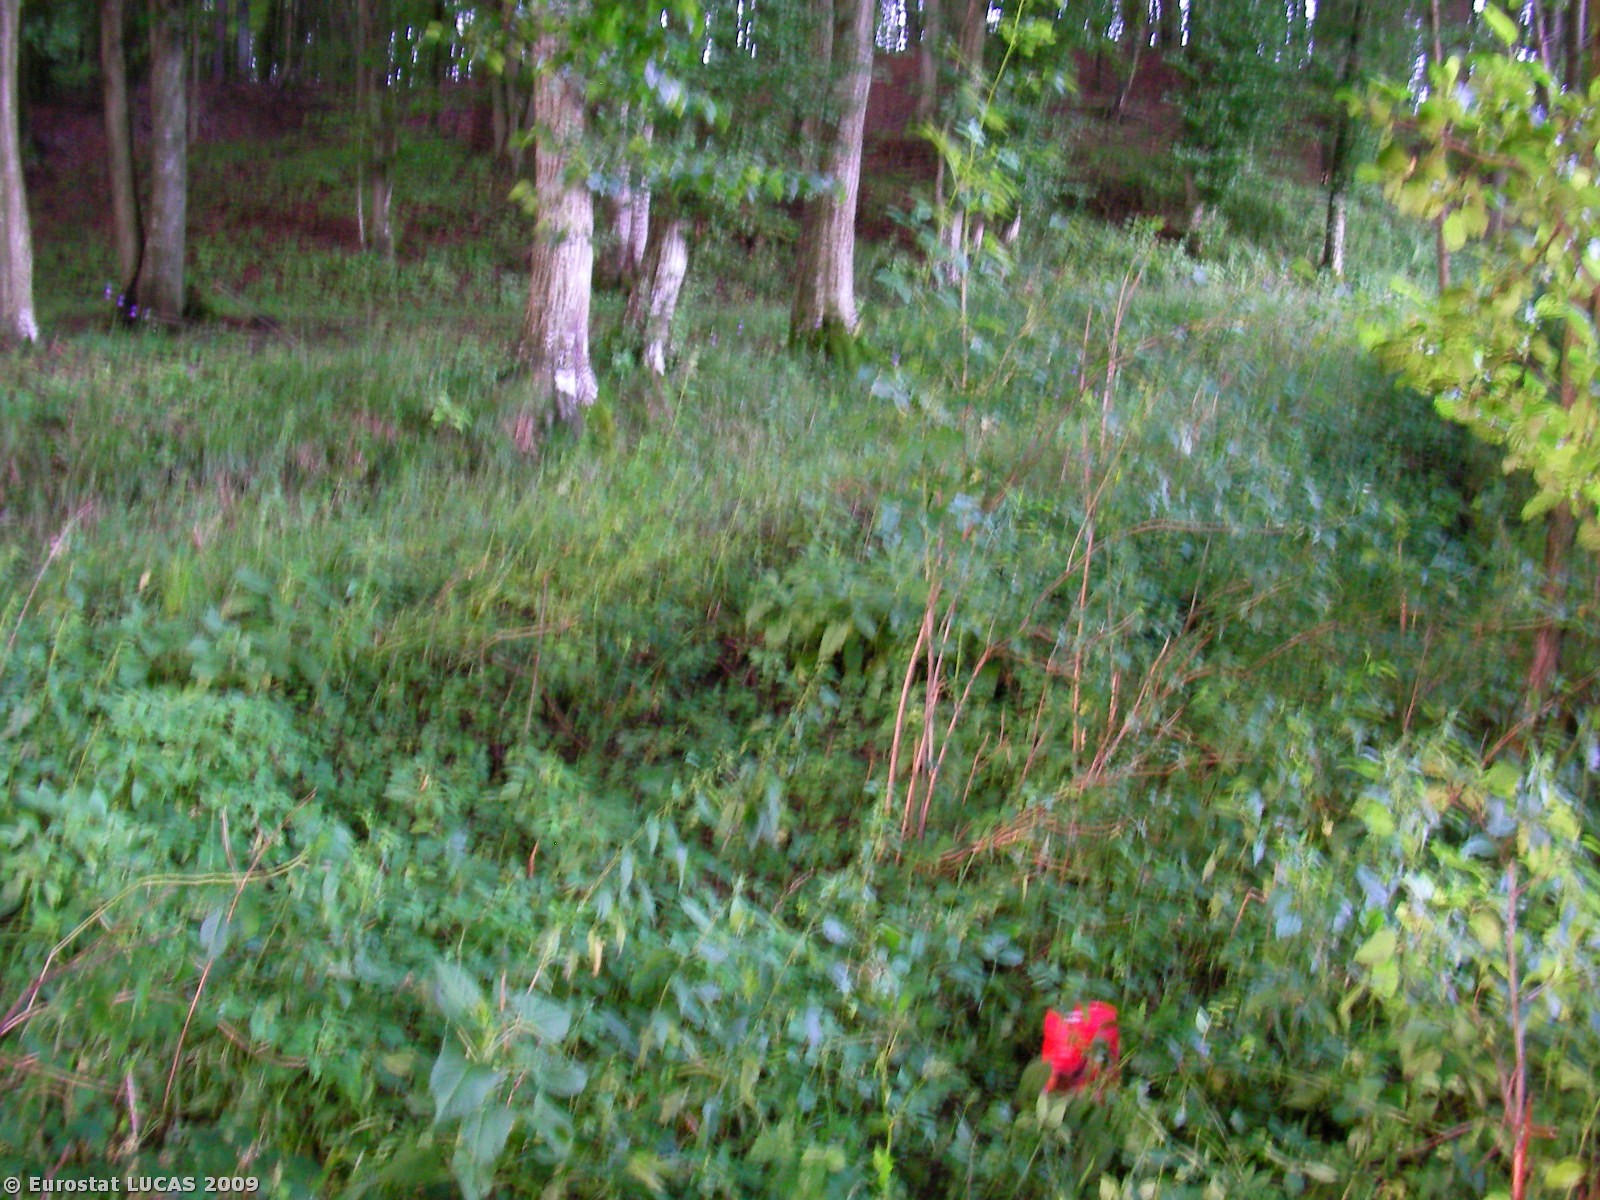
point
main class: Woodland
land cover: Broadleaved woodland
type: beech forest
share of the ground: > 75 %
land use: Forestry
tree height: > 5 m
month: July
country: AT
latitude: 46.9745
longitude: 15.7183
